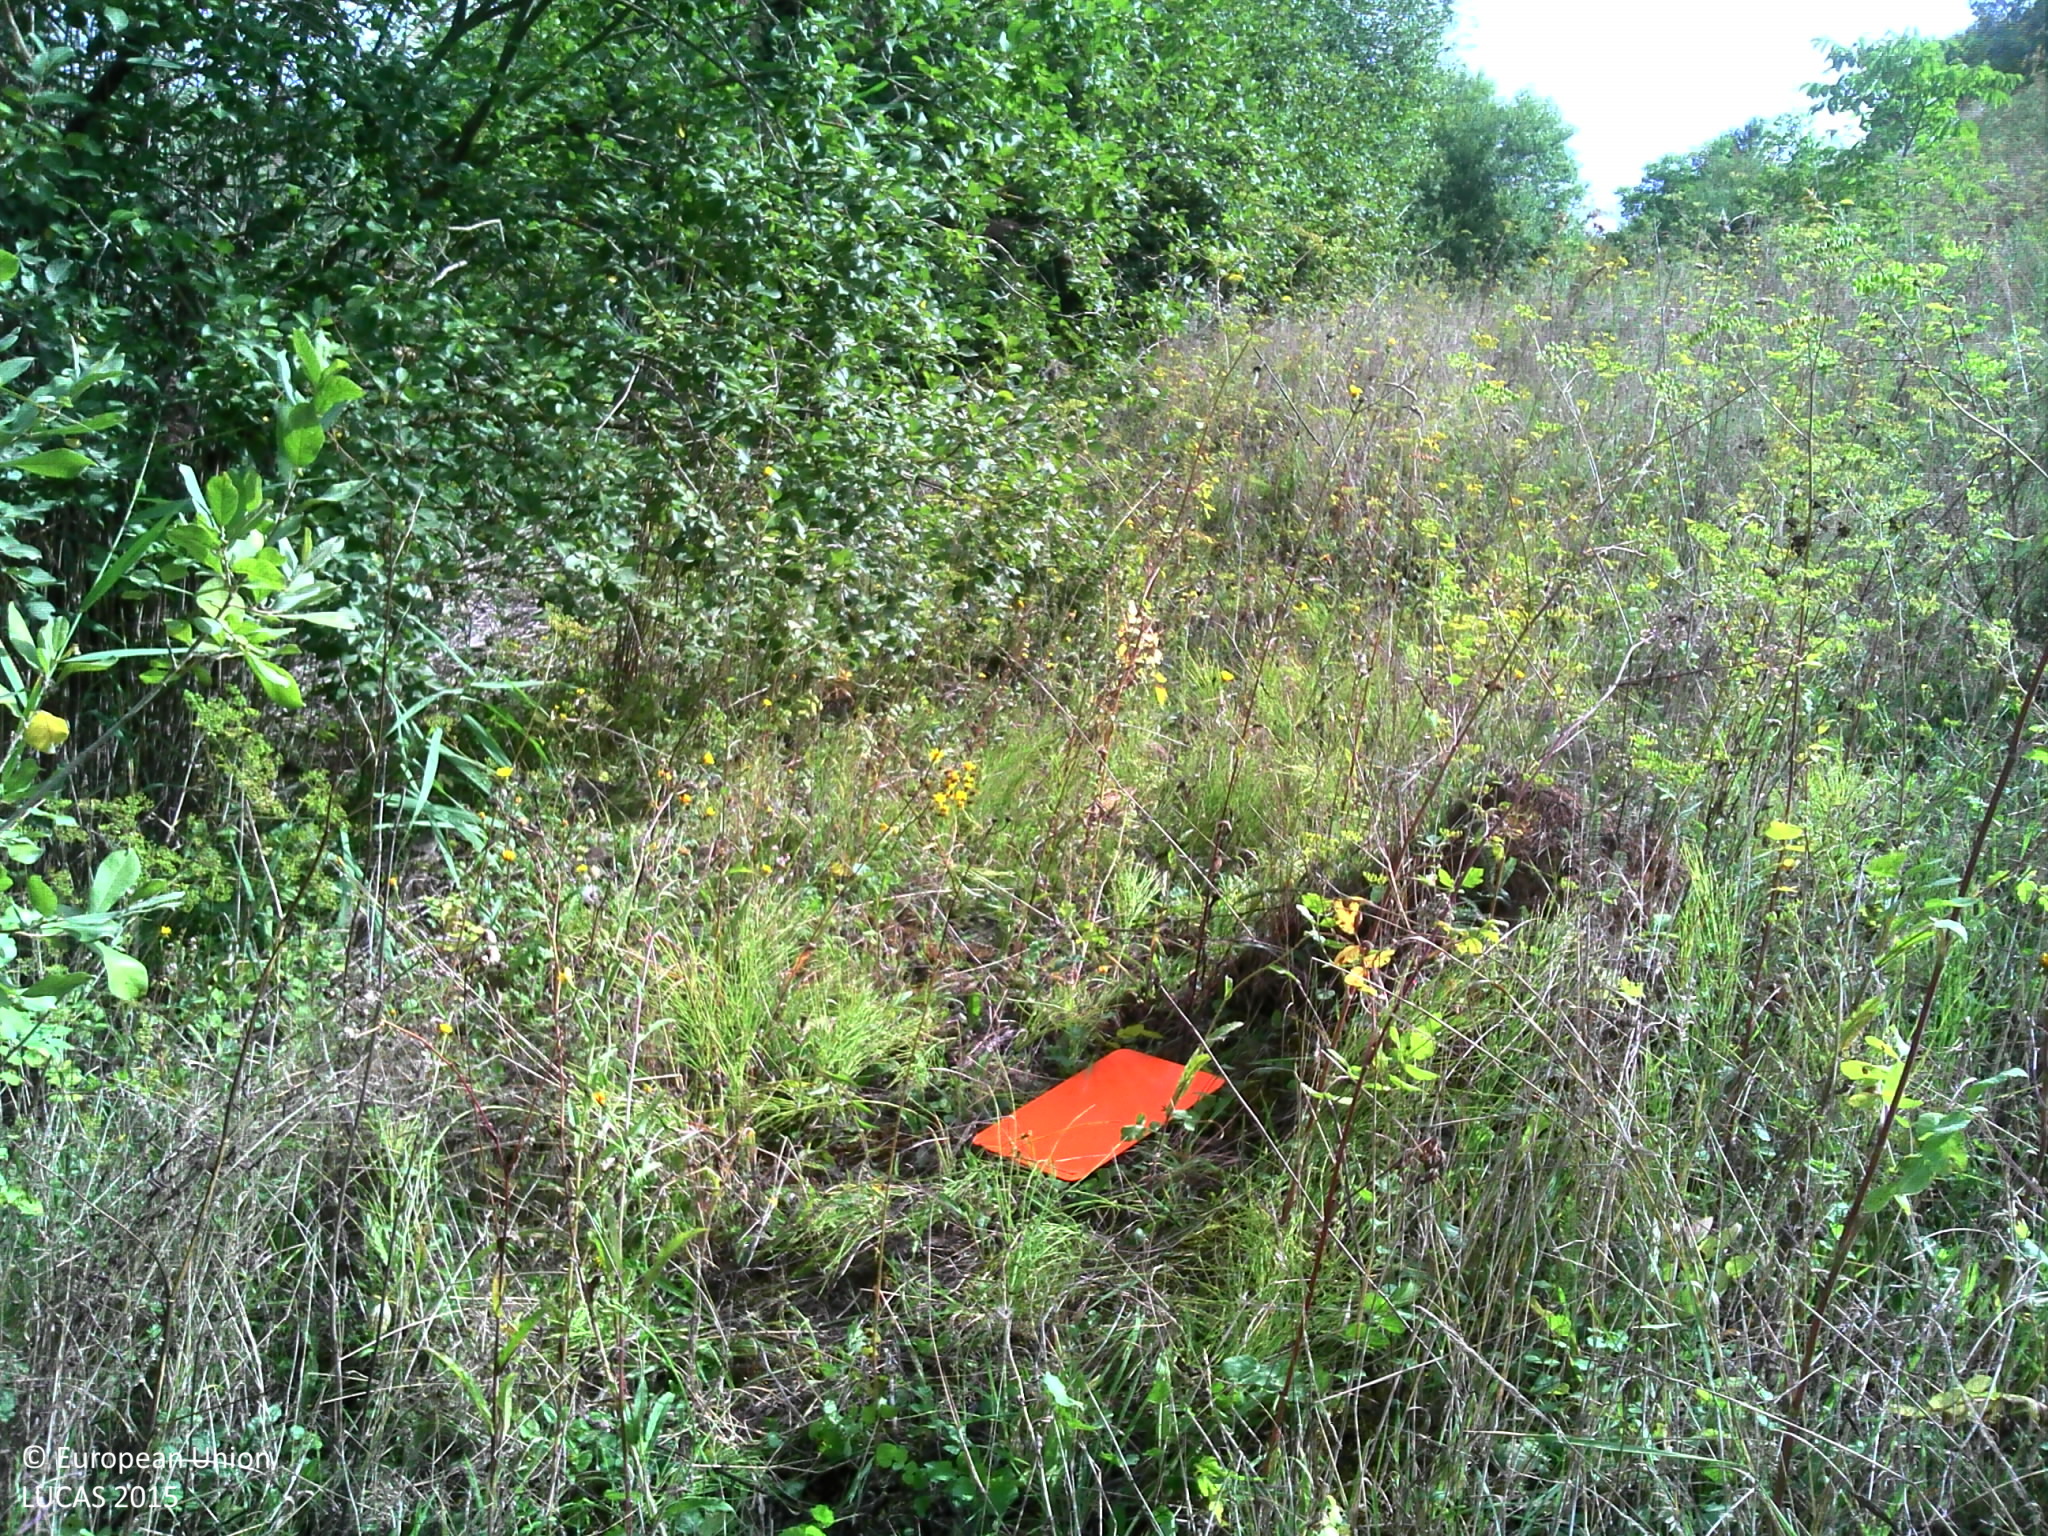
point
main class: Grassland
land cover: Spontaneously vegetated surfaces
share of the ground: > 75 %
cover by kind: herbaceous plants 95 %, shrubs 5 %
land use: Semi-natural and natural areas not in use
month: September
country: FR
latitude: 48.5513
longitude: 6.1120
